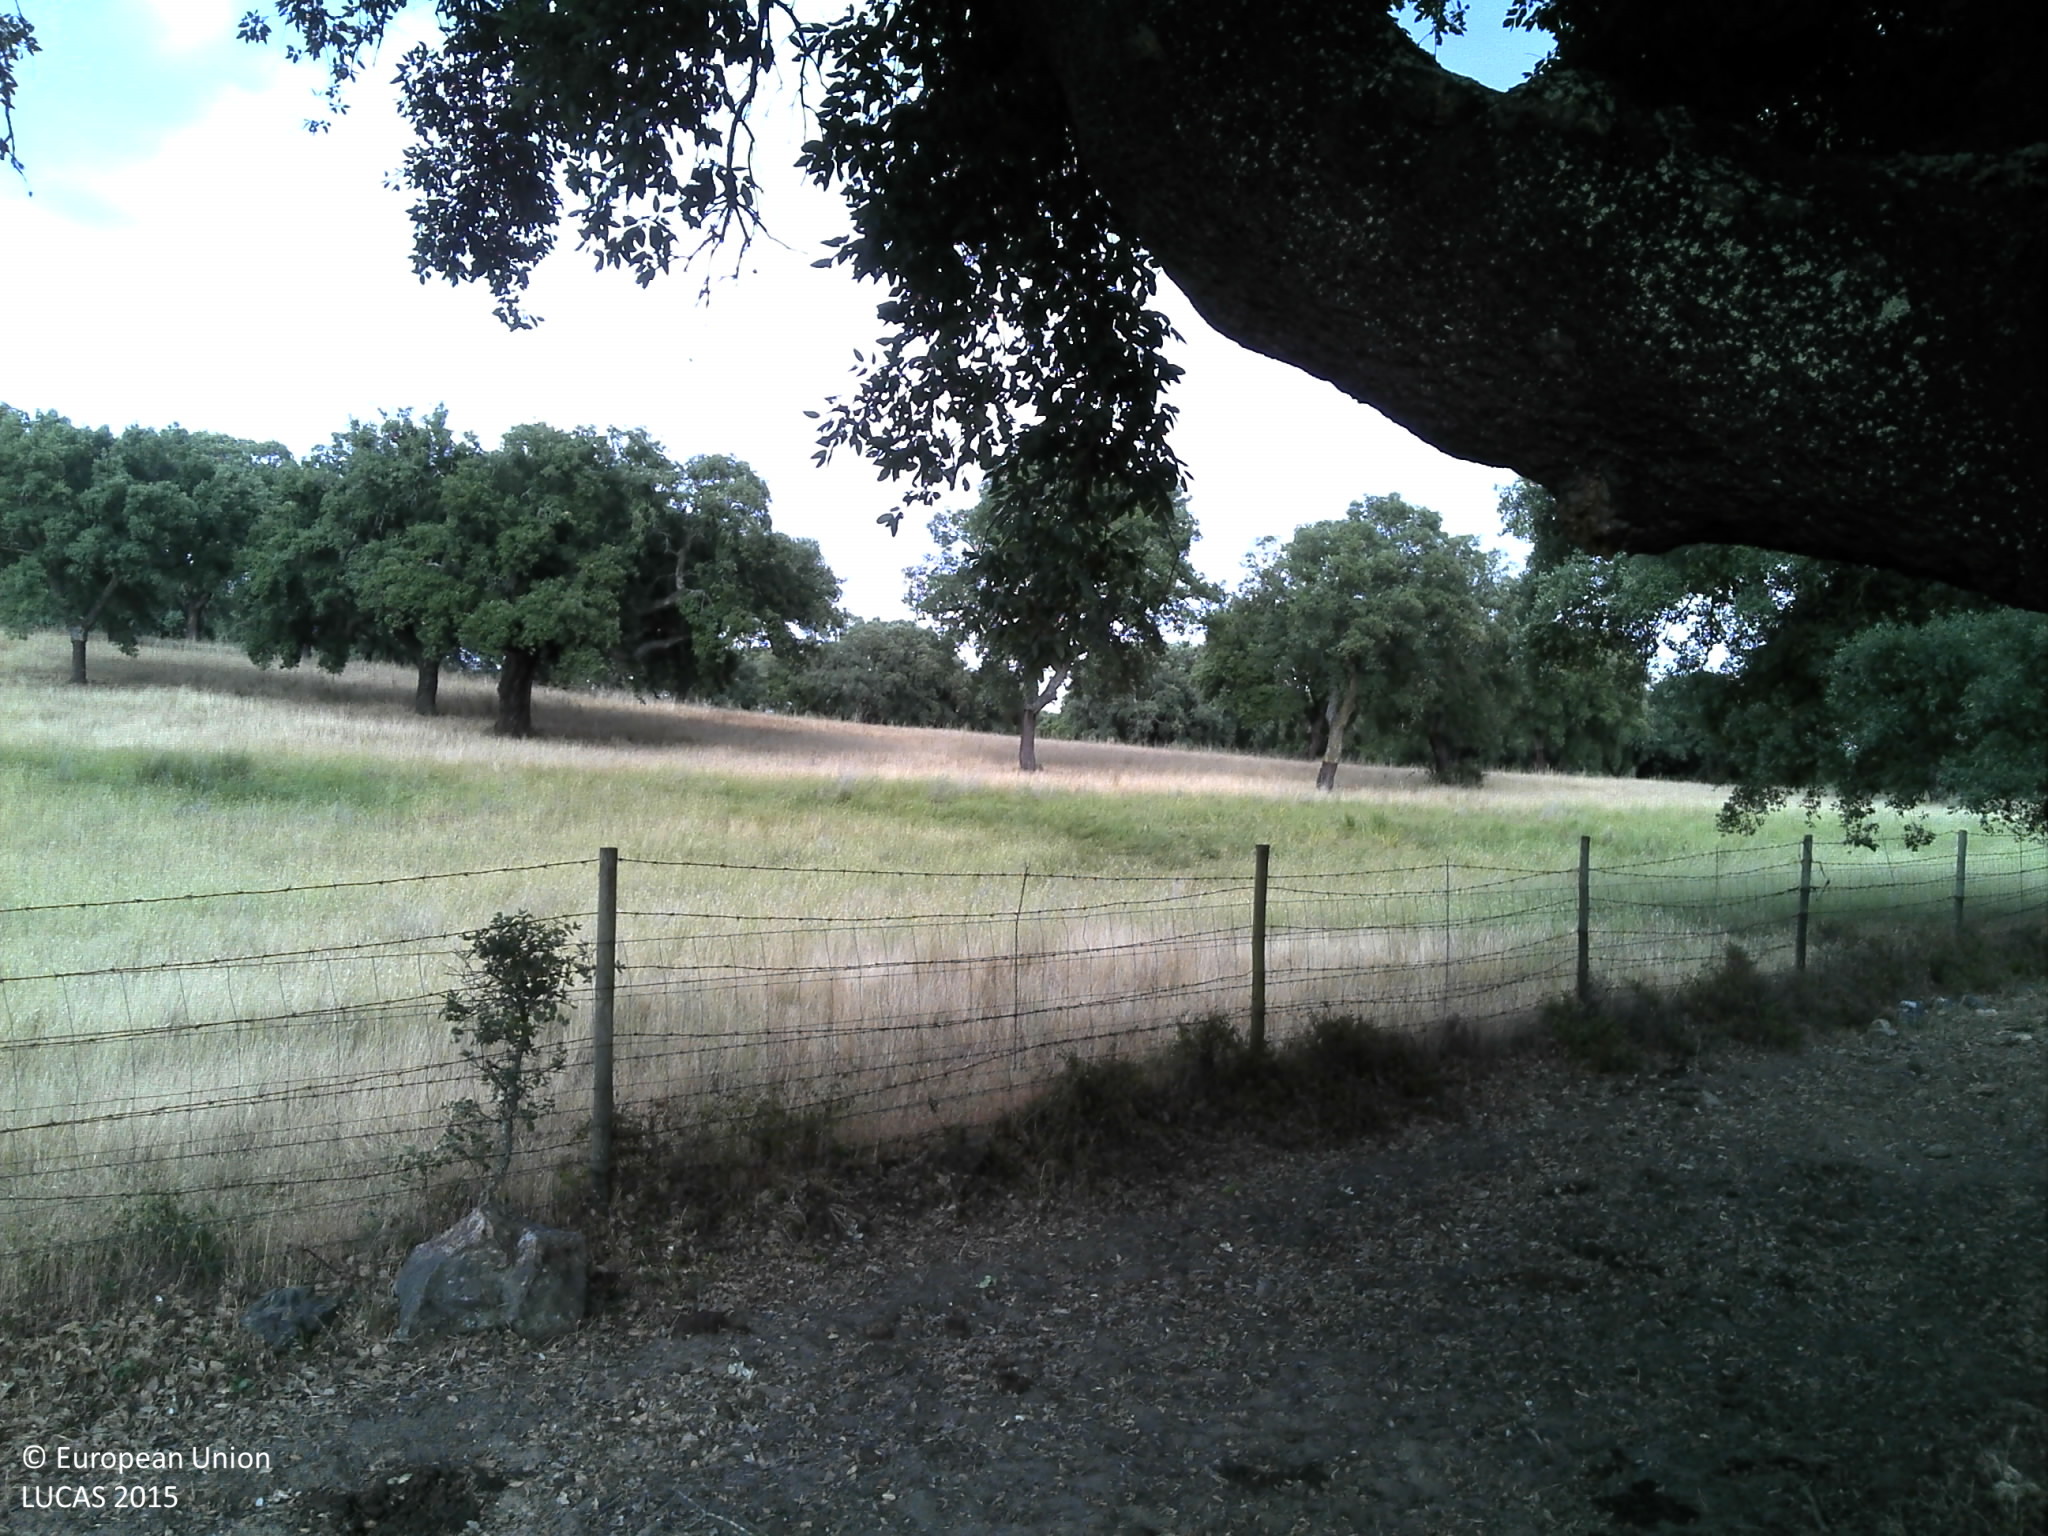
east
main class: Woodland
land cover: Broadleaved woodland
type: broadleaved evergreen forest
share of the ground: 25 - 50 %
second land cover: Grassland without tree/shrub cover
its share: < 10 %
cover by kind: unconsolidated bare surface 50 %, broadleaved forest trees 40 %, herbaceous plants 10 %
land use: Forestry
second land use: Agriculture (excluding fallow land and kitchen gardens)
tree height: > 5 m
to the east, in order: Broadleaved woodland; Grassland without tree/shrub cover; Fences; Broadleaved woodland
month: June
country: PT
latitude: 38.5773
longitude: -8.1474
